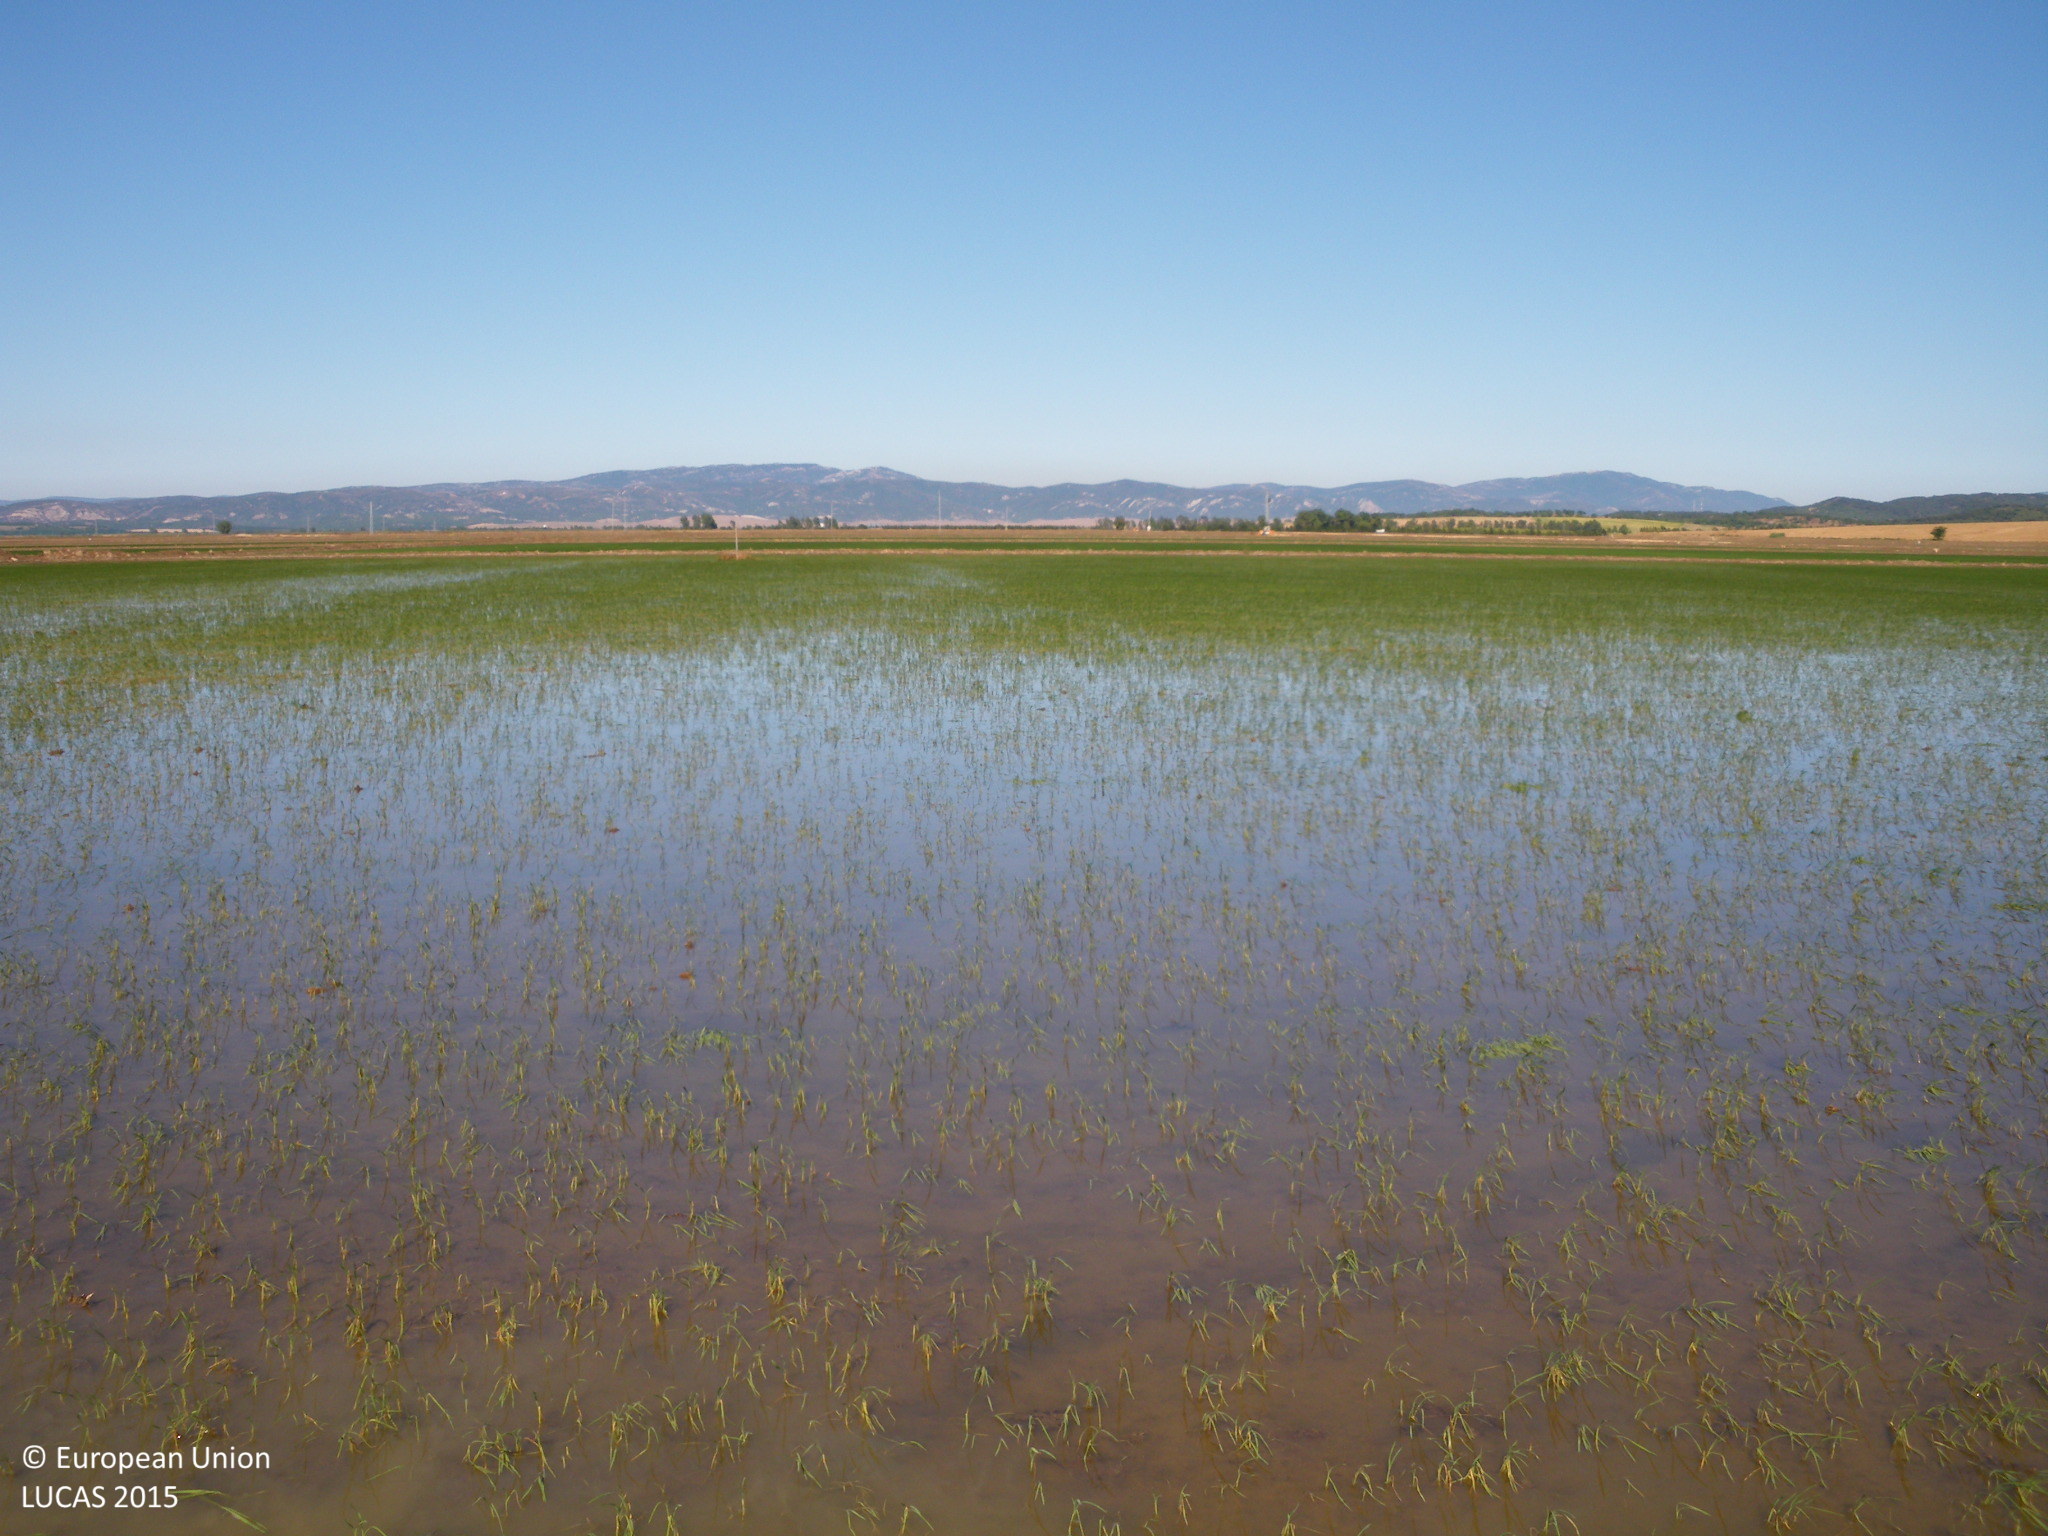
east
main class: Cropland
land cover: Rice
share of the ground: > 75 %
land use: Agriculture (excluding fallow land and kitchen gardens)
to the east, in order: Rice; Artificial constructions; Rice; Artificial constructions; Rice
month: June
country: ES
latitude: 36.2383
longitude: -5.8775
